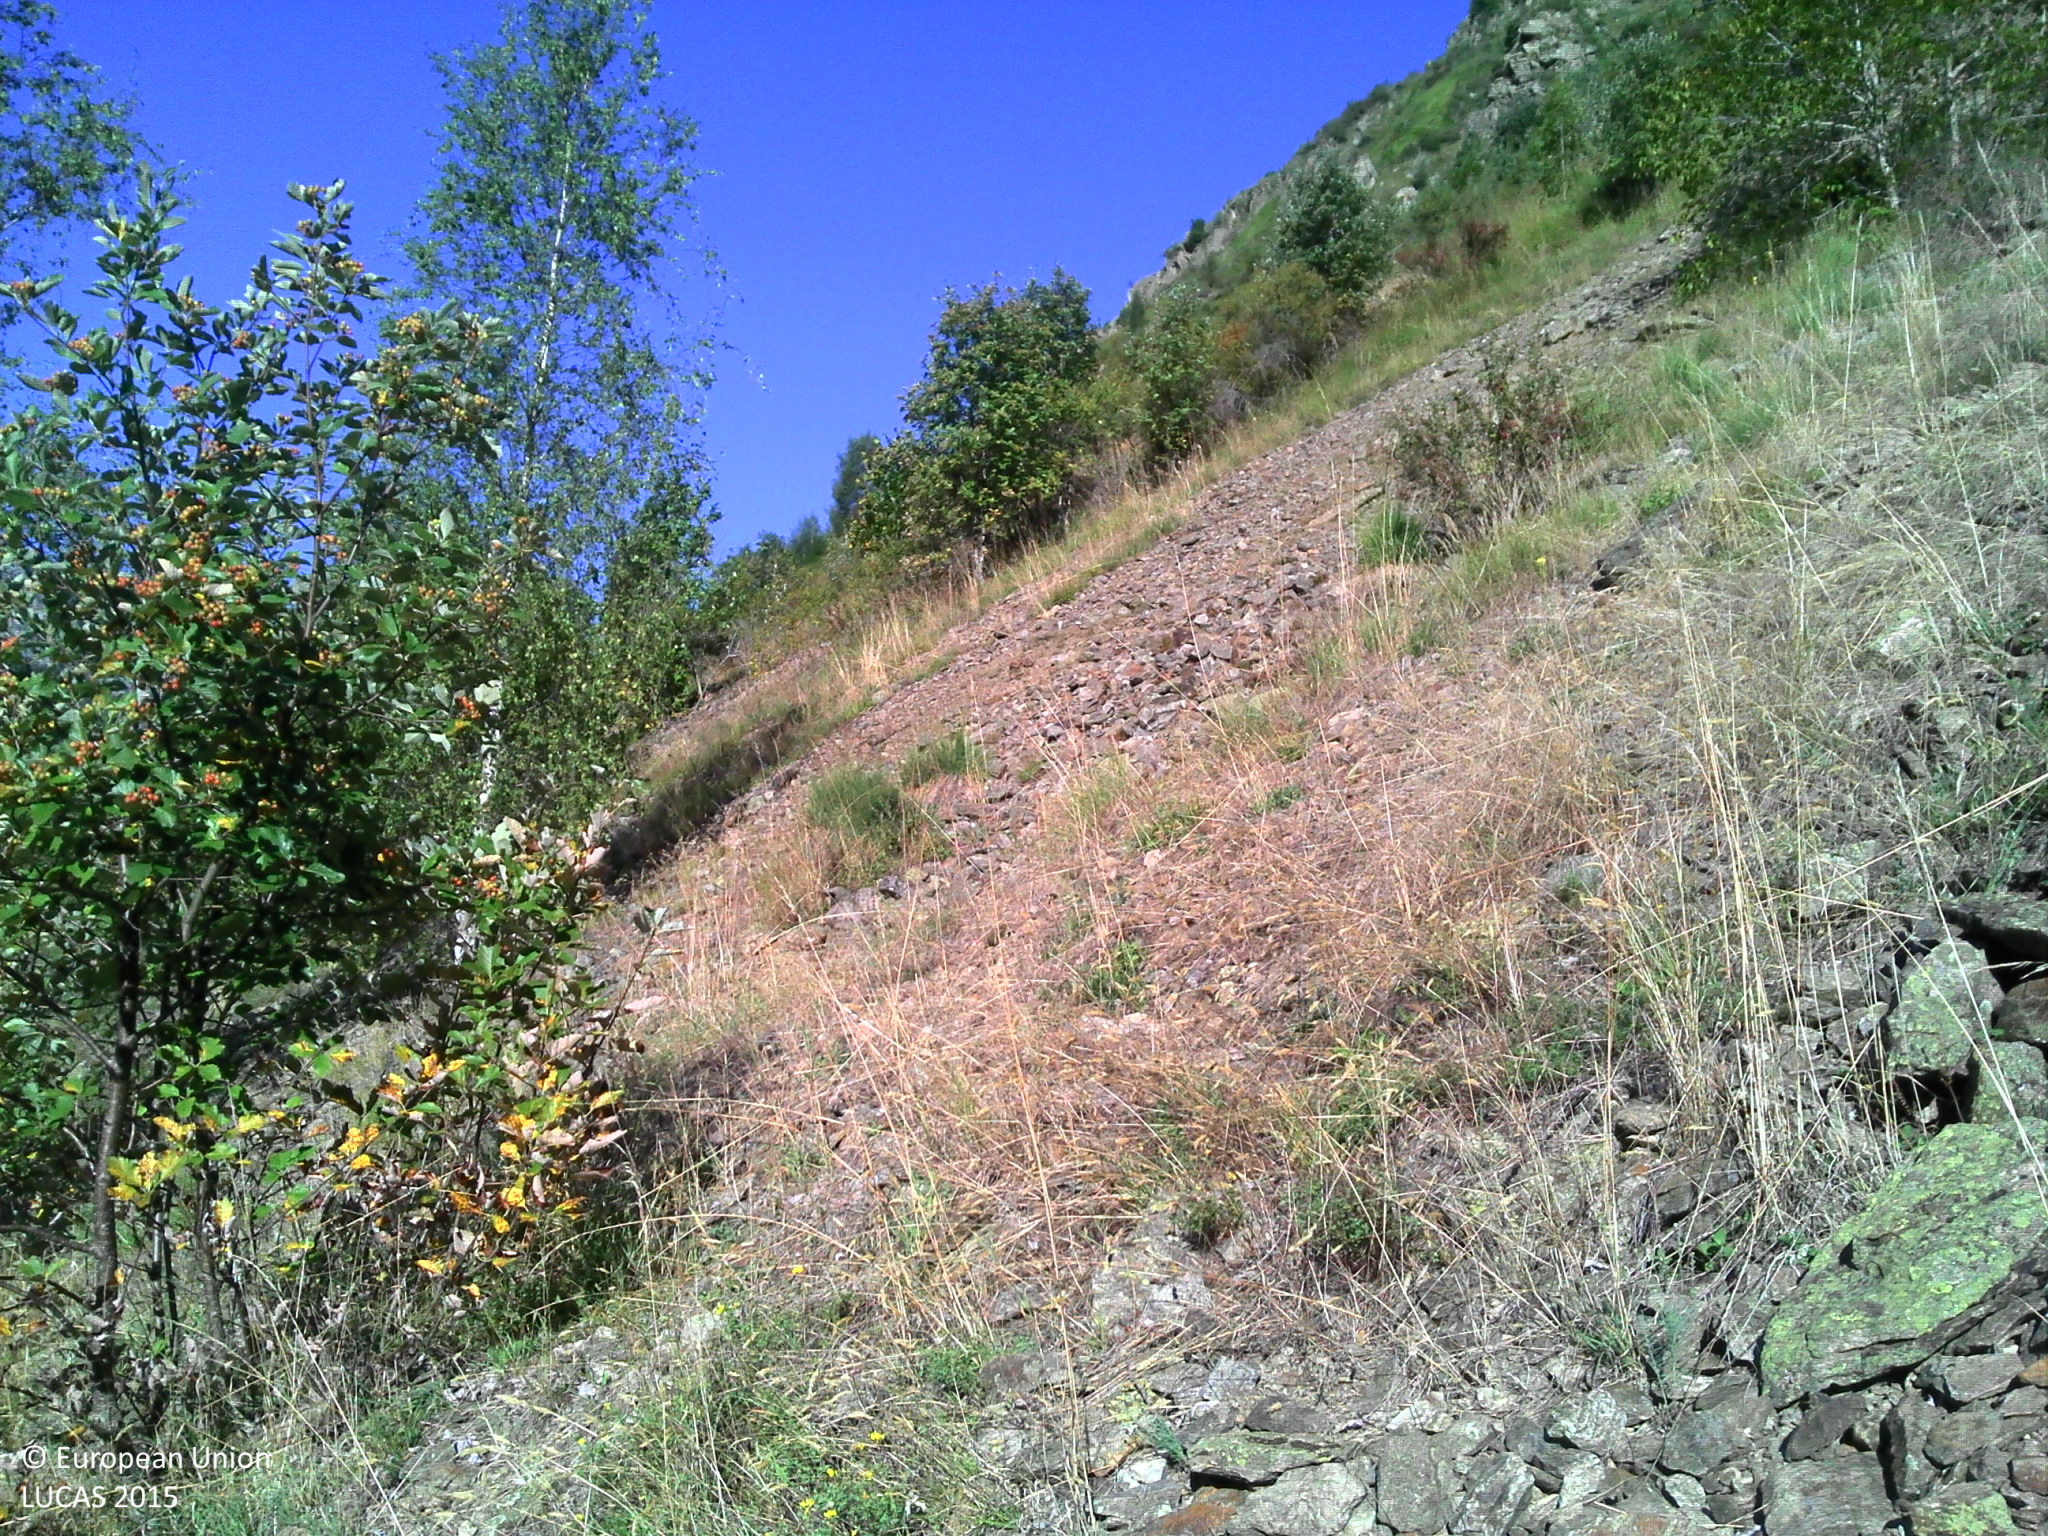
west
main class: Shrubland
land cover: Shrubland with sparse tree cover
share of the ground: > 75 %
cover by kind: consolidated bare surface 60 %, herbaceous plants 20 %, shrubs 15 %, broadleaved forest trees 5 %
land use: Semi-natural and natural areas not in use
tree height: > 5 m
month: August
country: FR
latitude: 44.8225
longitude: 6.1993
